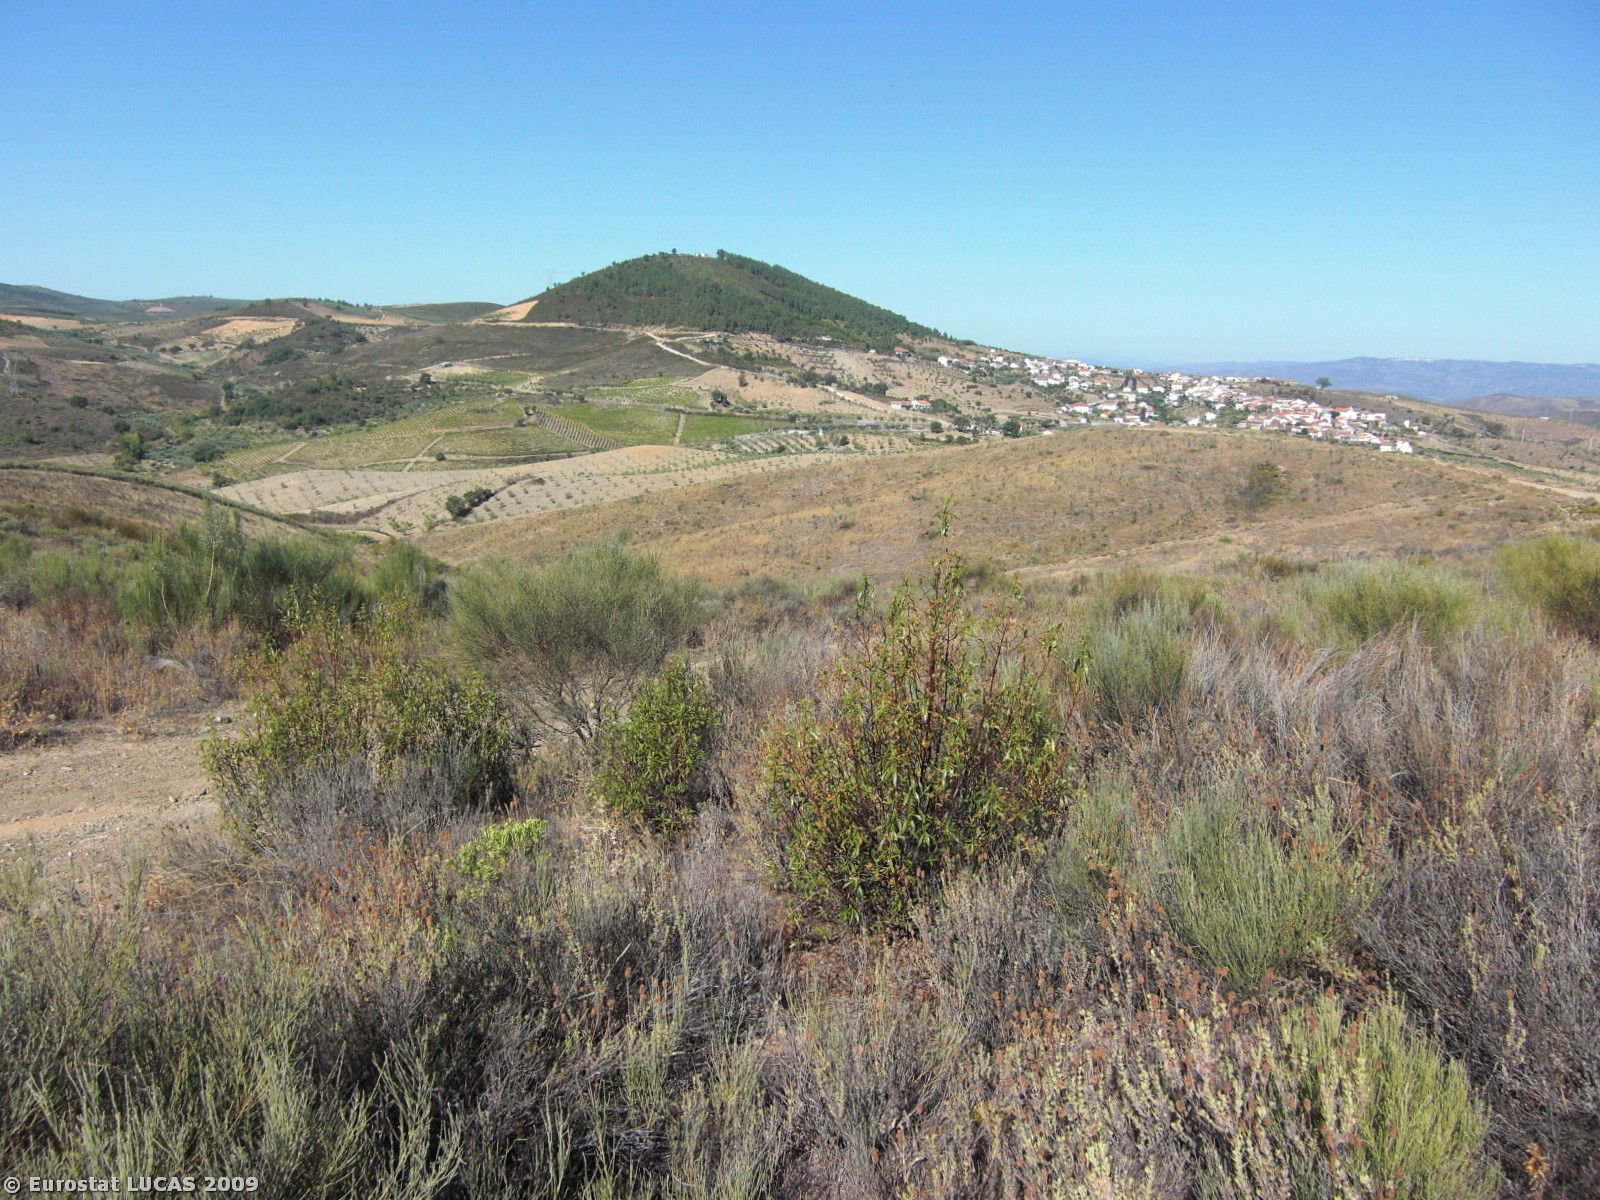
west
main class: Shrubland
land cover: Shrubland without tree cover
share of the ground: > 75 %
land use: Fallow land
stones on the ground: > 50 %
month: August
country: PT
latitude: 41.0841
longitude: -6.9506
